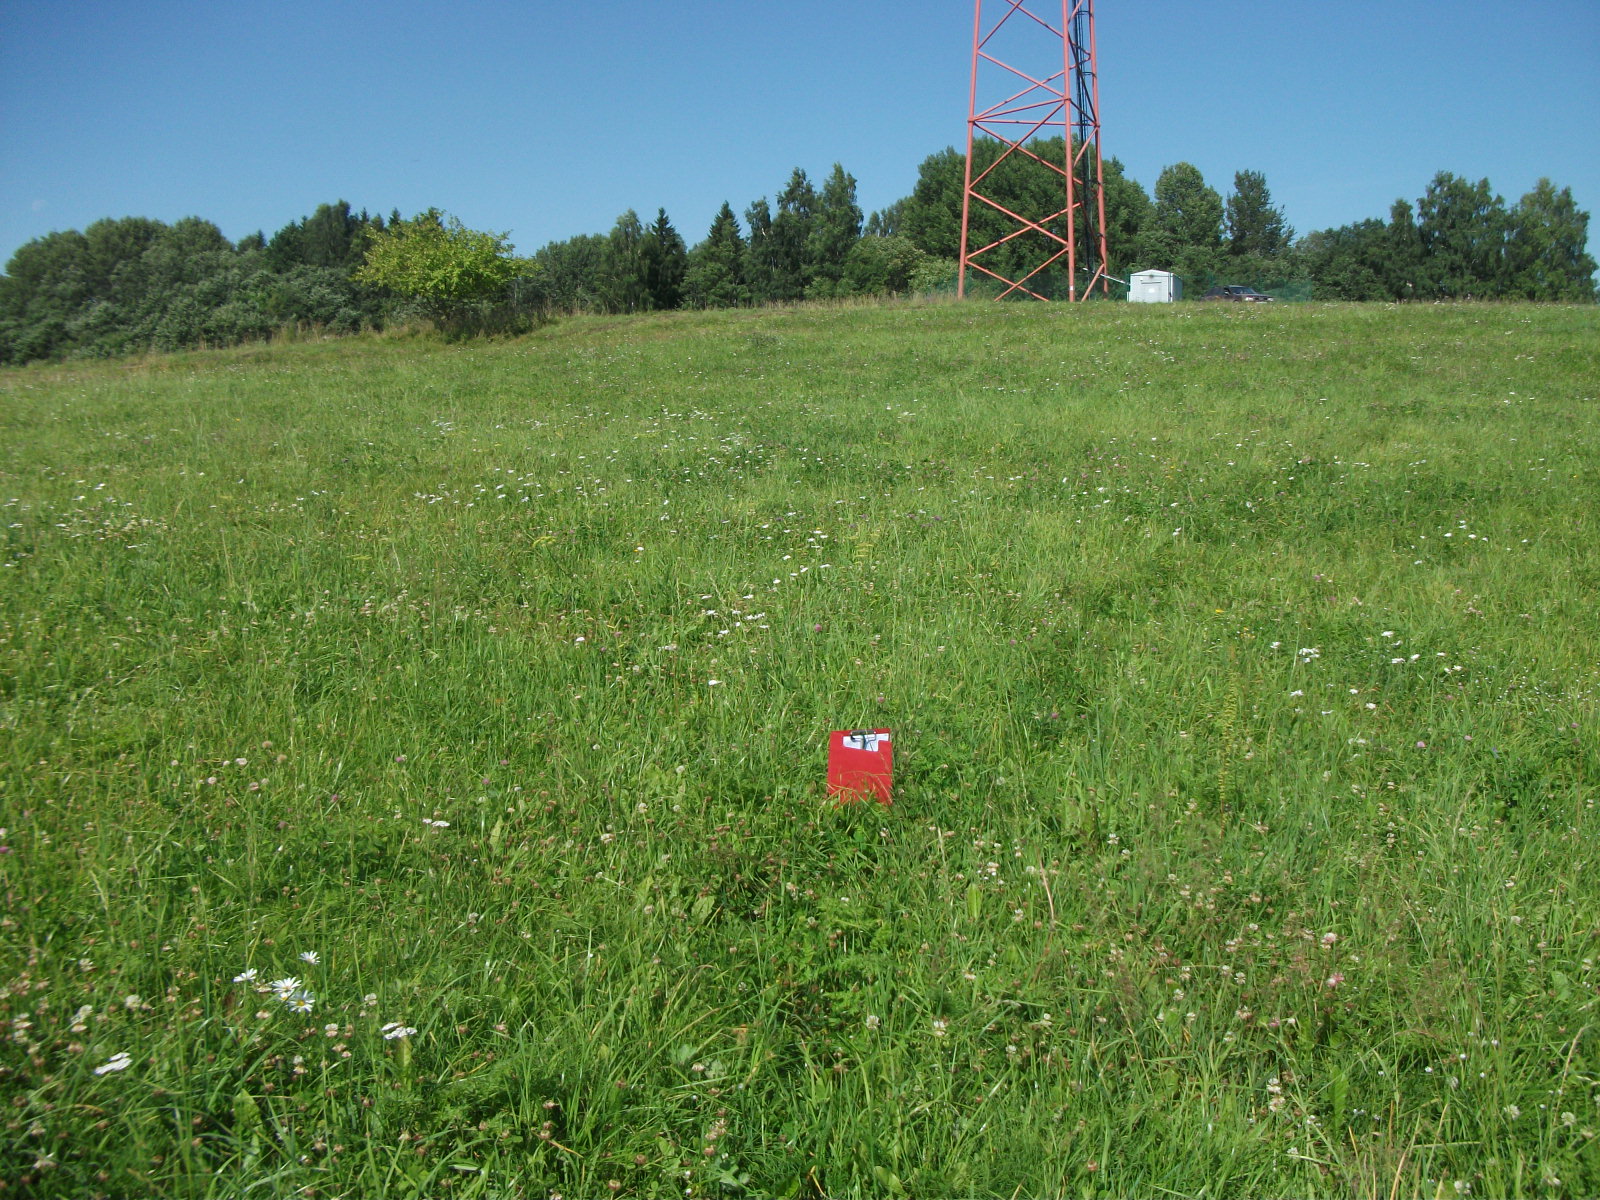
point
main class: Grassland
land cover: Grassland without tree/shrub cover
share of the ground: > 75 %
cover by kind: herbaceous plants 100 %
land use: Agriculture (excluding fallow land and kitchen gardens)
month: August
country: LV
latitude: 56.9284
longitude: 25.7845
